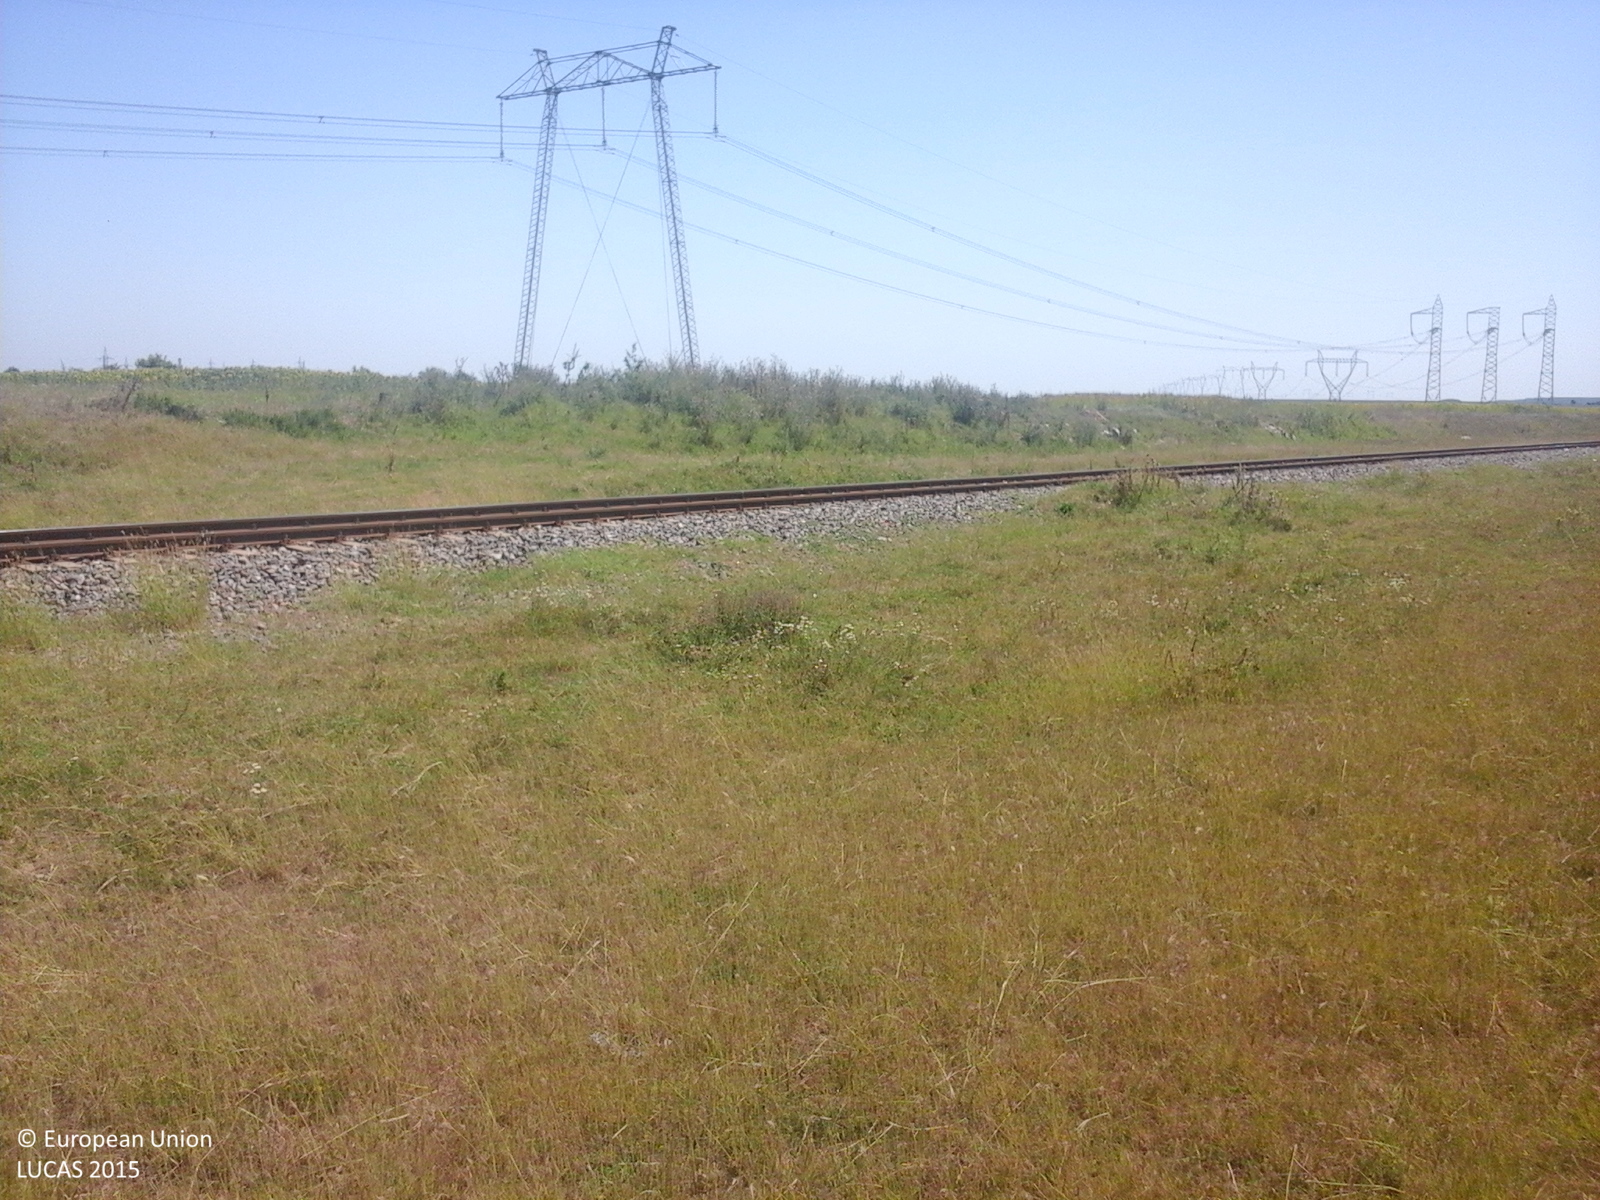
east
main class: Grassland
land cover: Spontaneously vegetated surfaces
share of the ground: > 75 %
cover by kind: herbaceous plants 100 %
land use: Fallow land
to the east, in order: Spontaneously vegetated surfaces; Railways; Spontaneously vegetated surfaces; Tracks; Spontaneously vegetated surfaces; Electric lines; Spontaneously vegetated surfaces; Sunflower
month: July
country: RO
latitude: 44.2196
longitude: 26.5746
